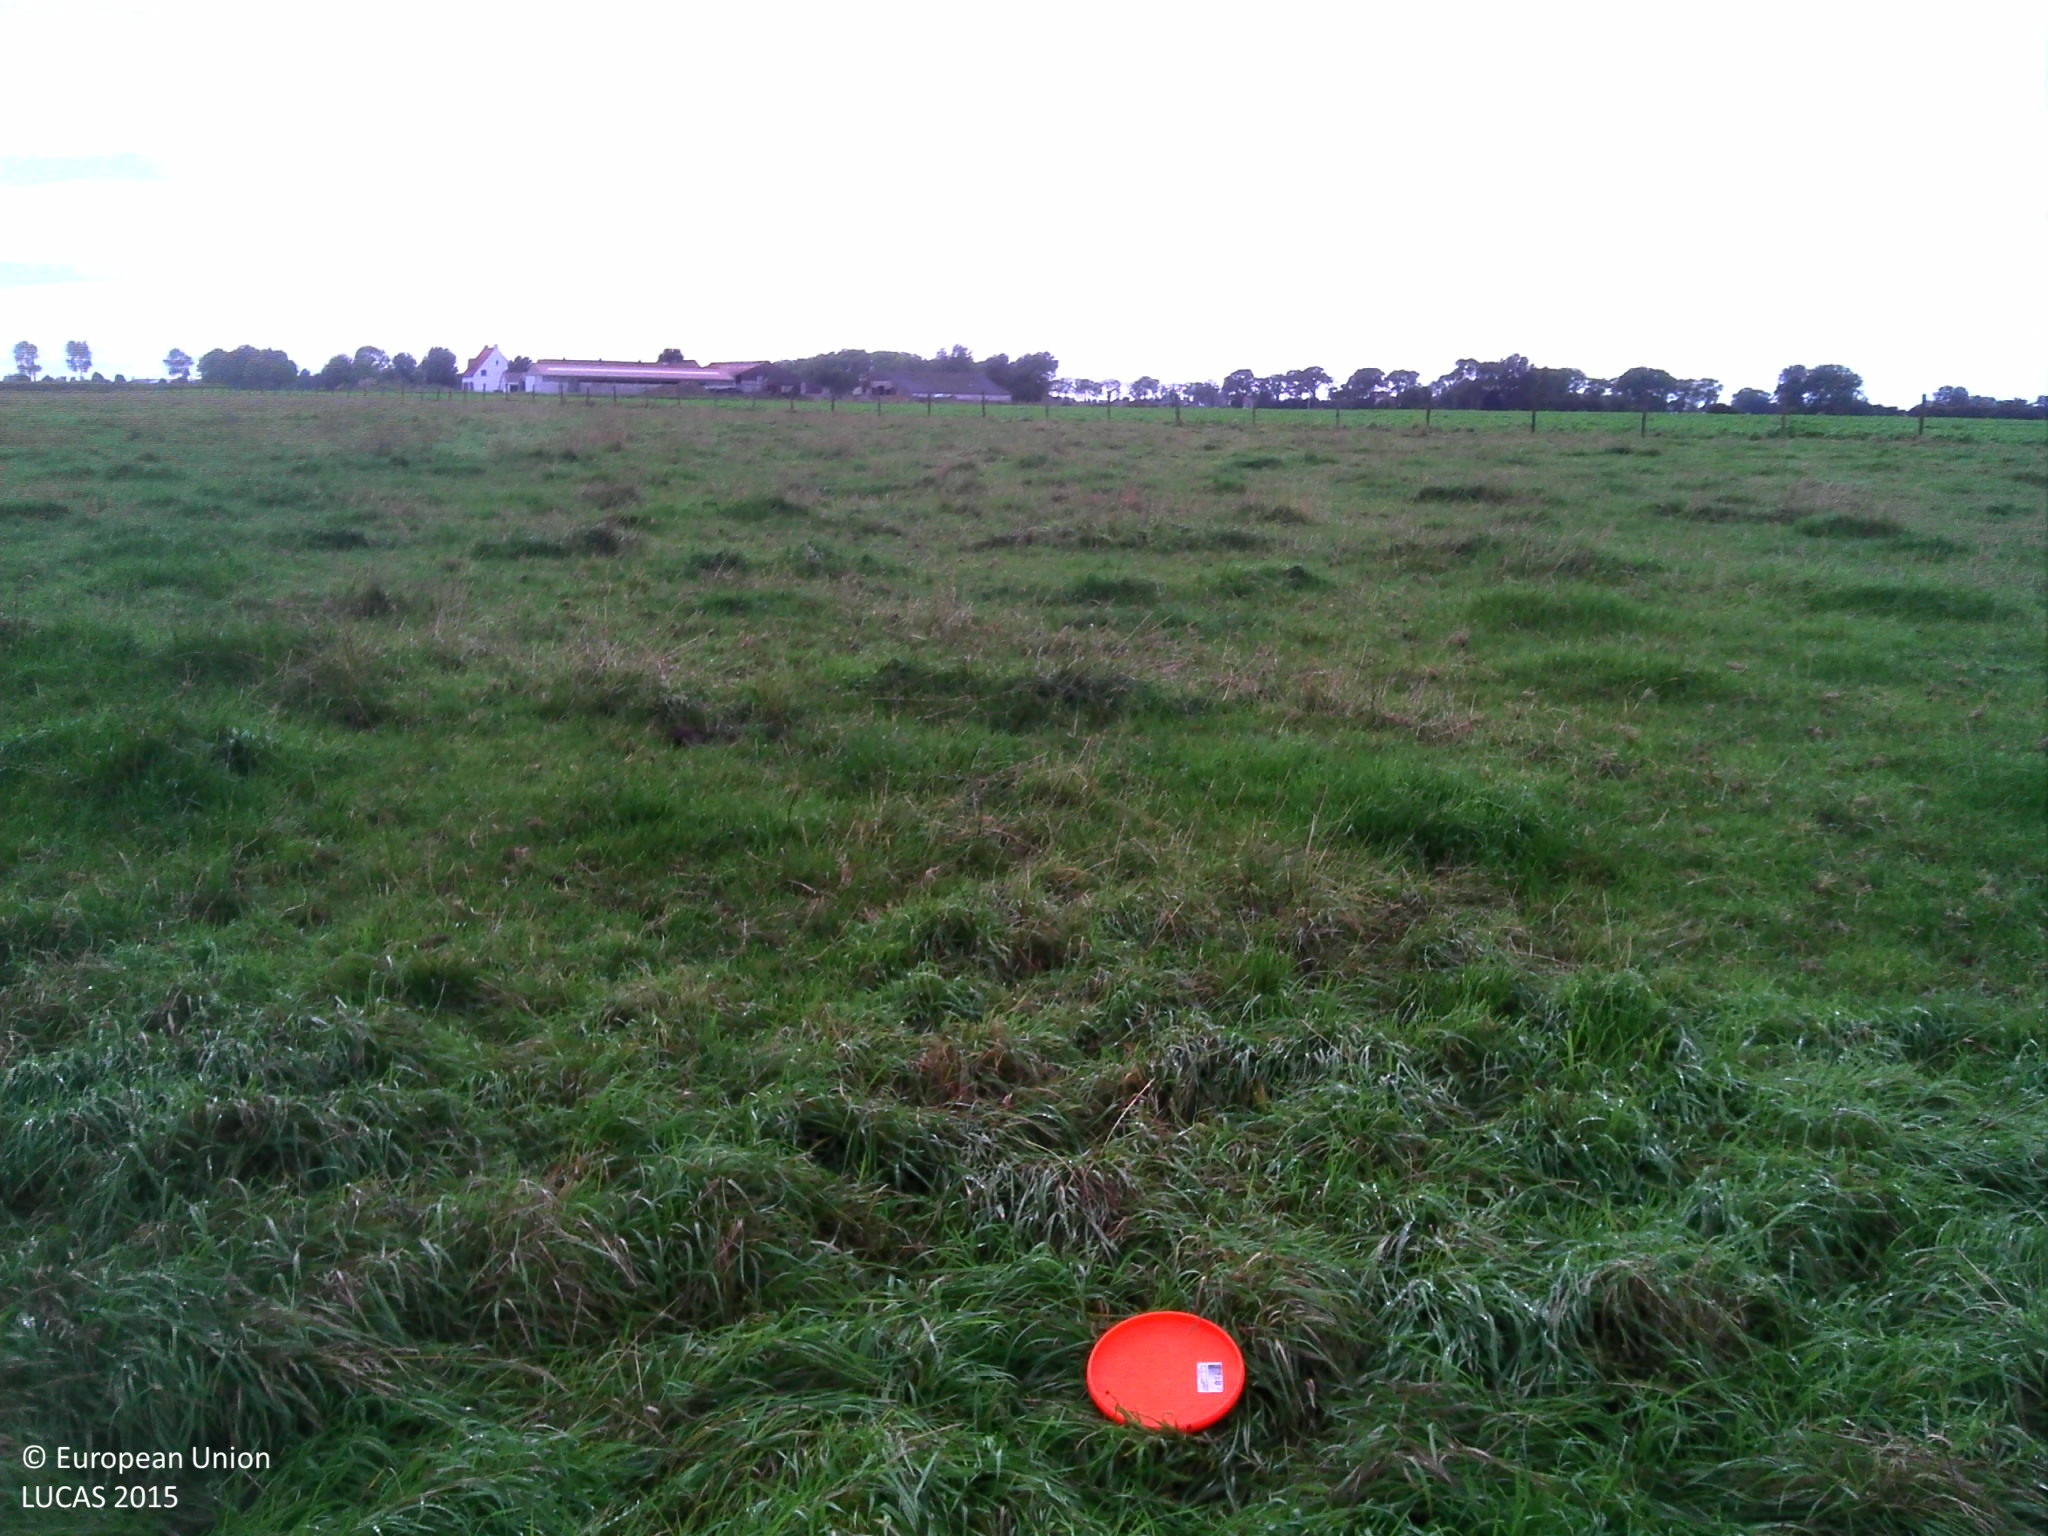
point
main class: Grassland
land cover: Grassland without tree/shrub cover
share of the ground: > 75 %
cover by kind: herbaceous plants 100 %
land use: Agriculture (excluding fallow land and kitchen gardens)
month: September
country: BE
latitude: 51.0978
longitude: 2.8636
